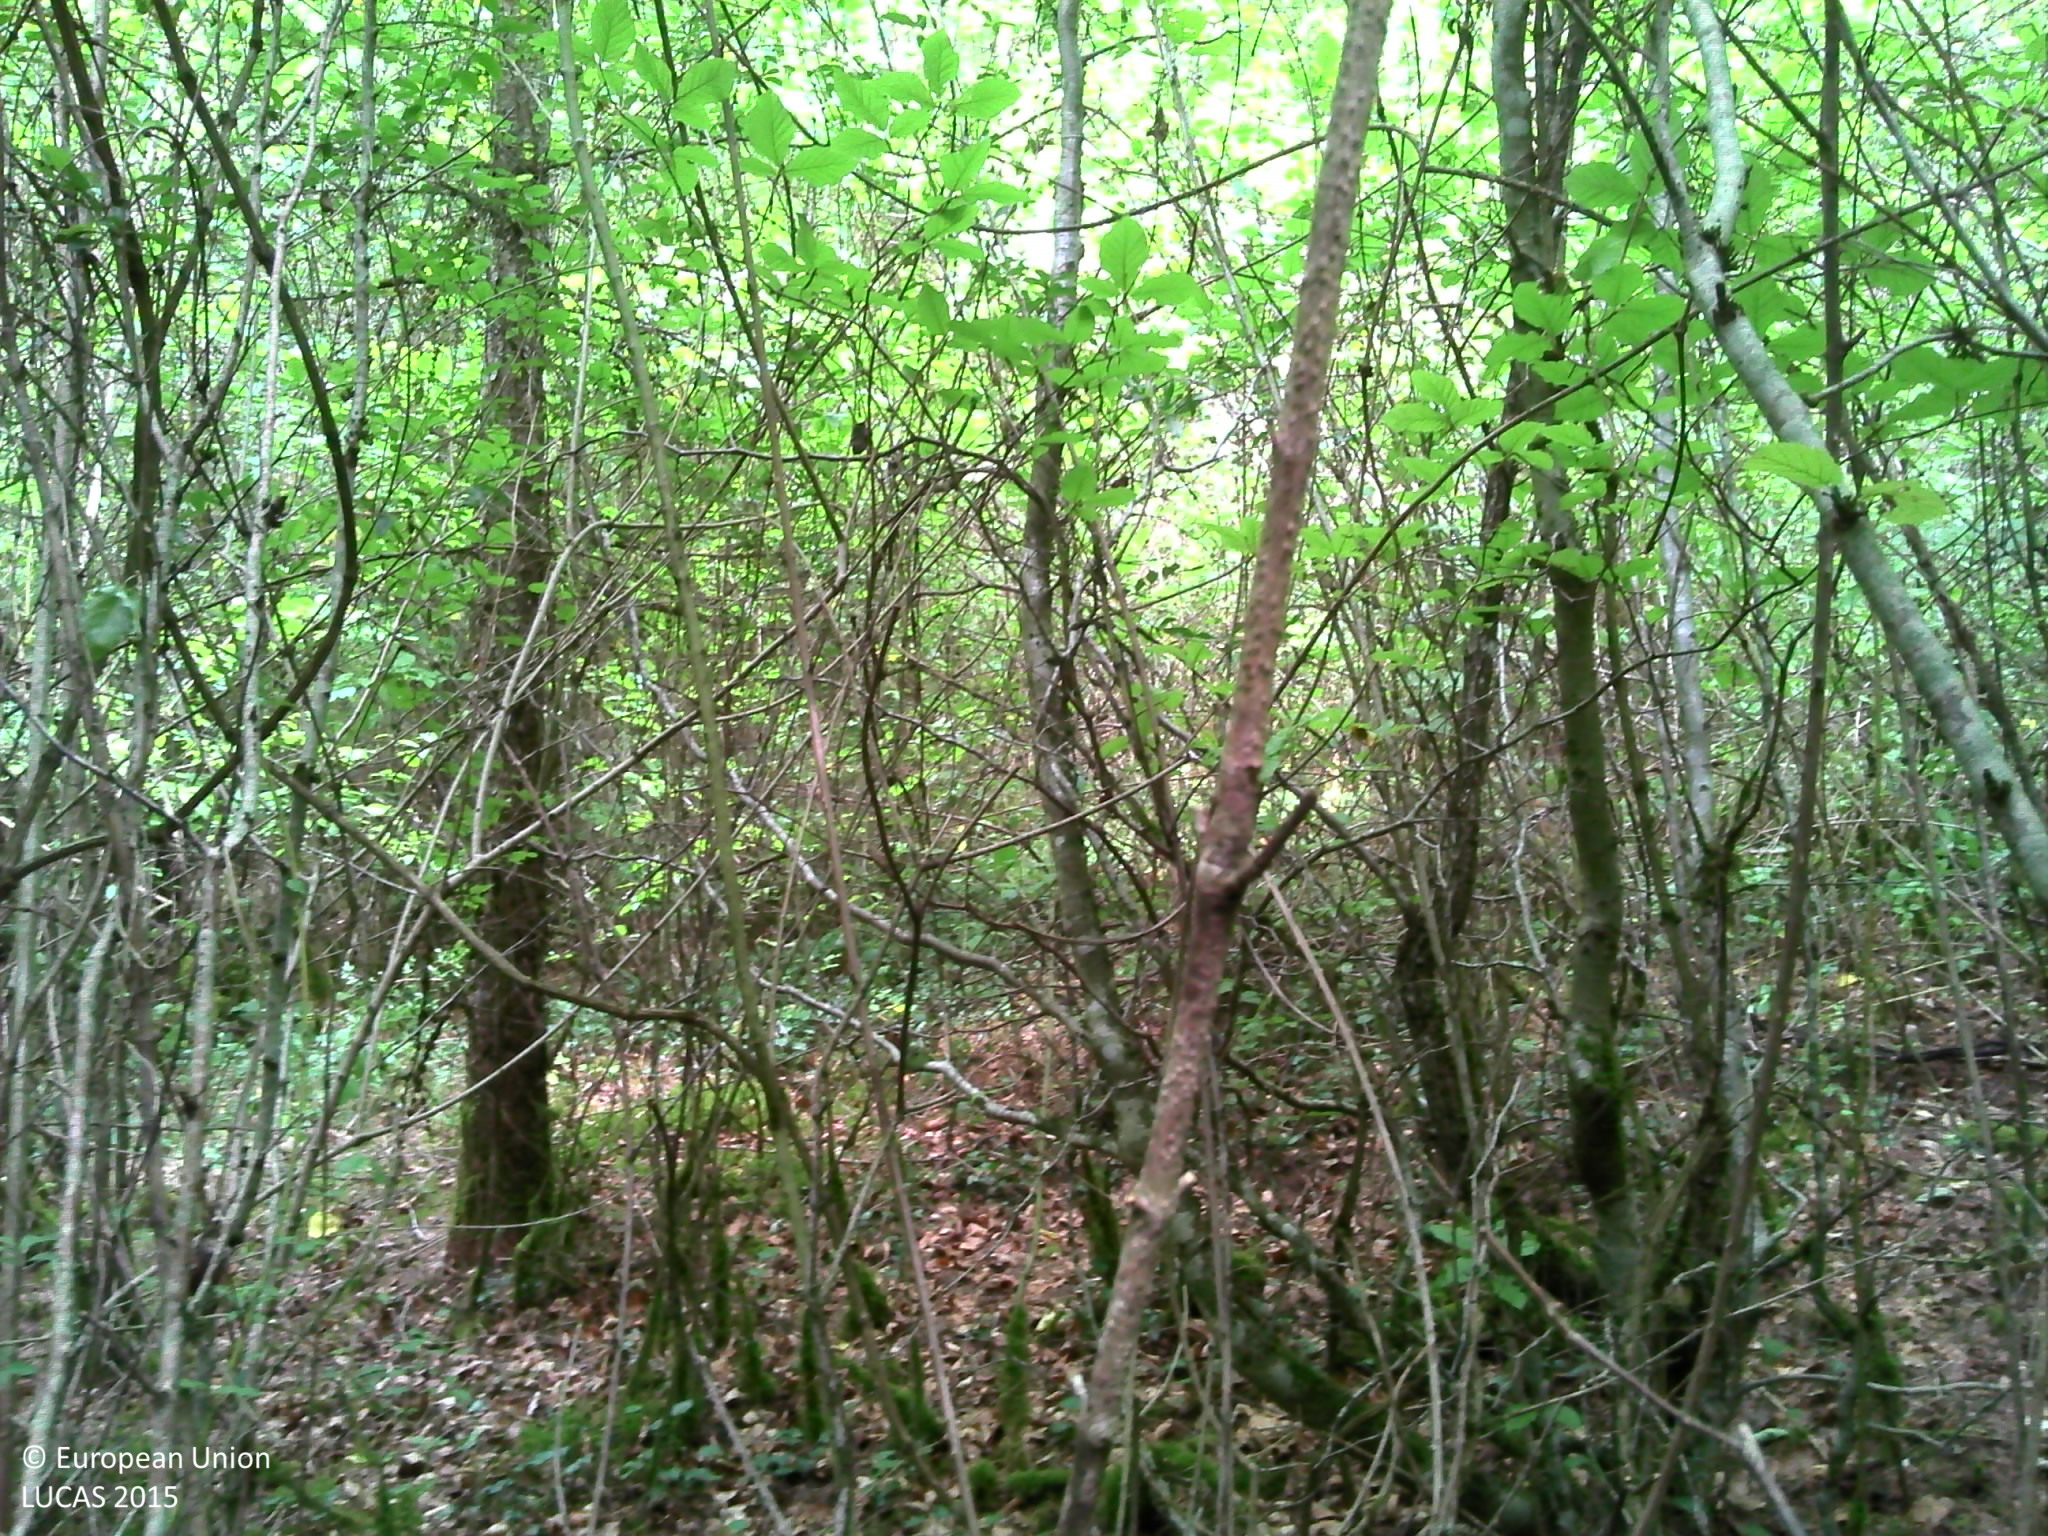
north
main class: Woodland
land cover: Other mixed woodland
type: exotic forest
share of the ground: > 75 %
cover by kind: coniferous forest trees 50 %, broadleaved forest trees 40 %, herbaceous plants 5 %, lichens and mosses 5 %
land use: Forestry
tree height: > 5 m
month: August
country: FR
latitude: 47.6919
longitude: 4.9232
